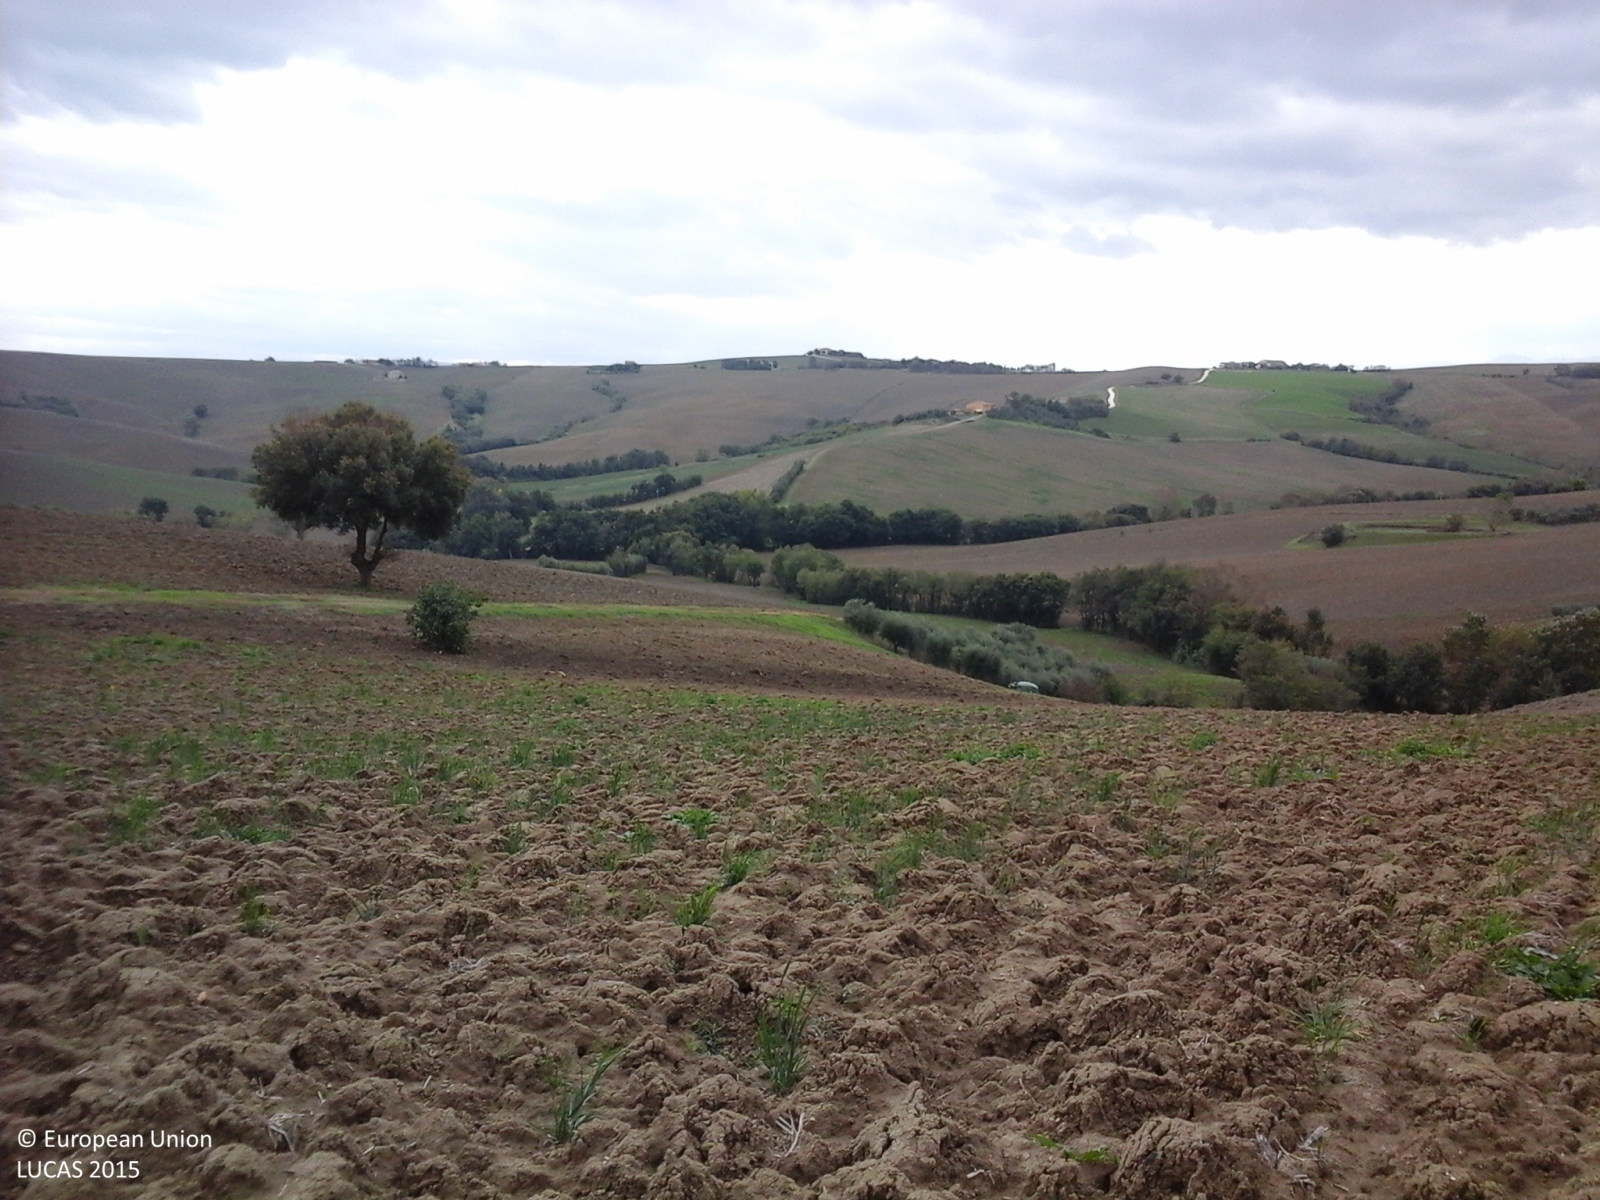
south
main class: Cropland
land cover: Durum wheat
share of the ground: < 10 %
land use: Agriculture (excluding fallow land and kitchen gardens)
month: October
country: IT
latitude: 43.5626
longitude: 13.1492
